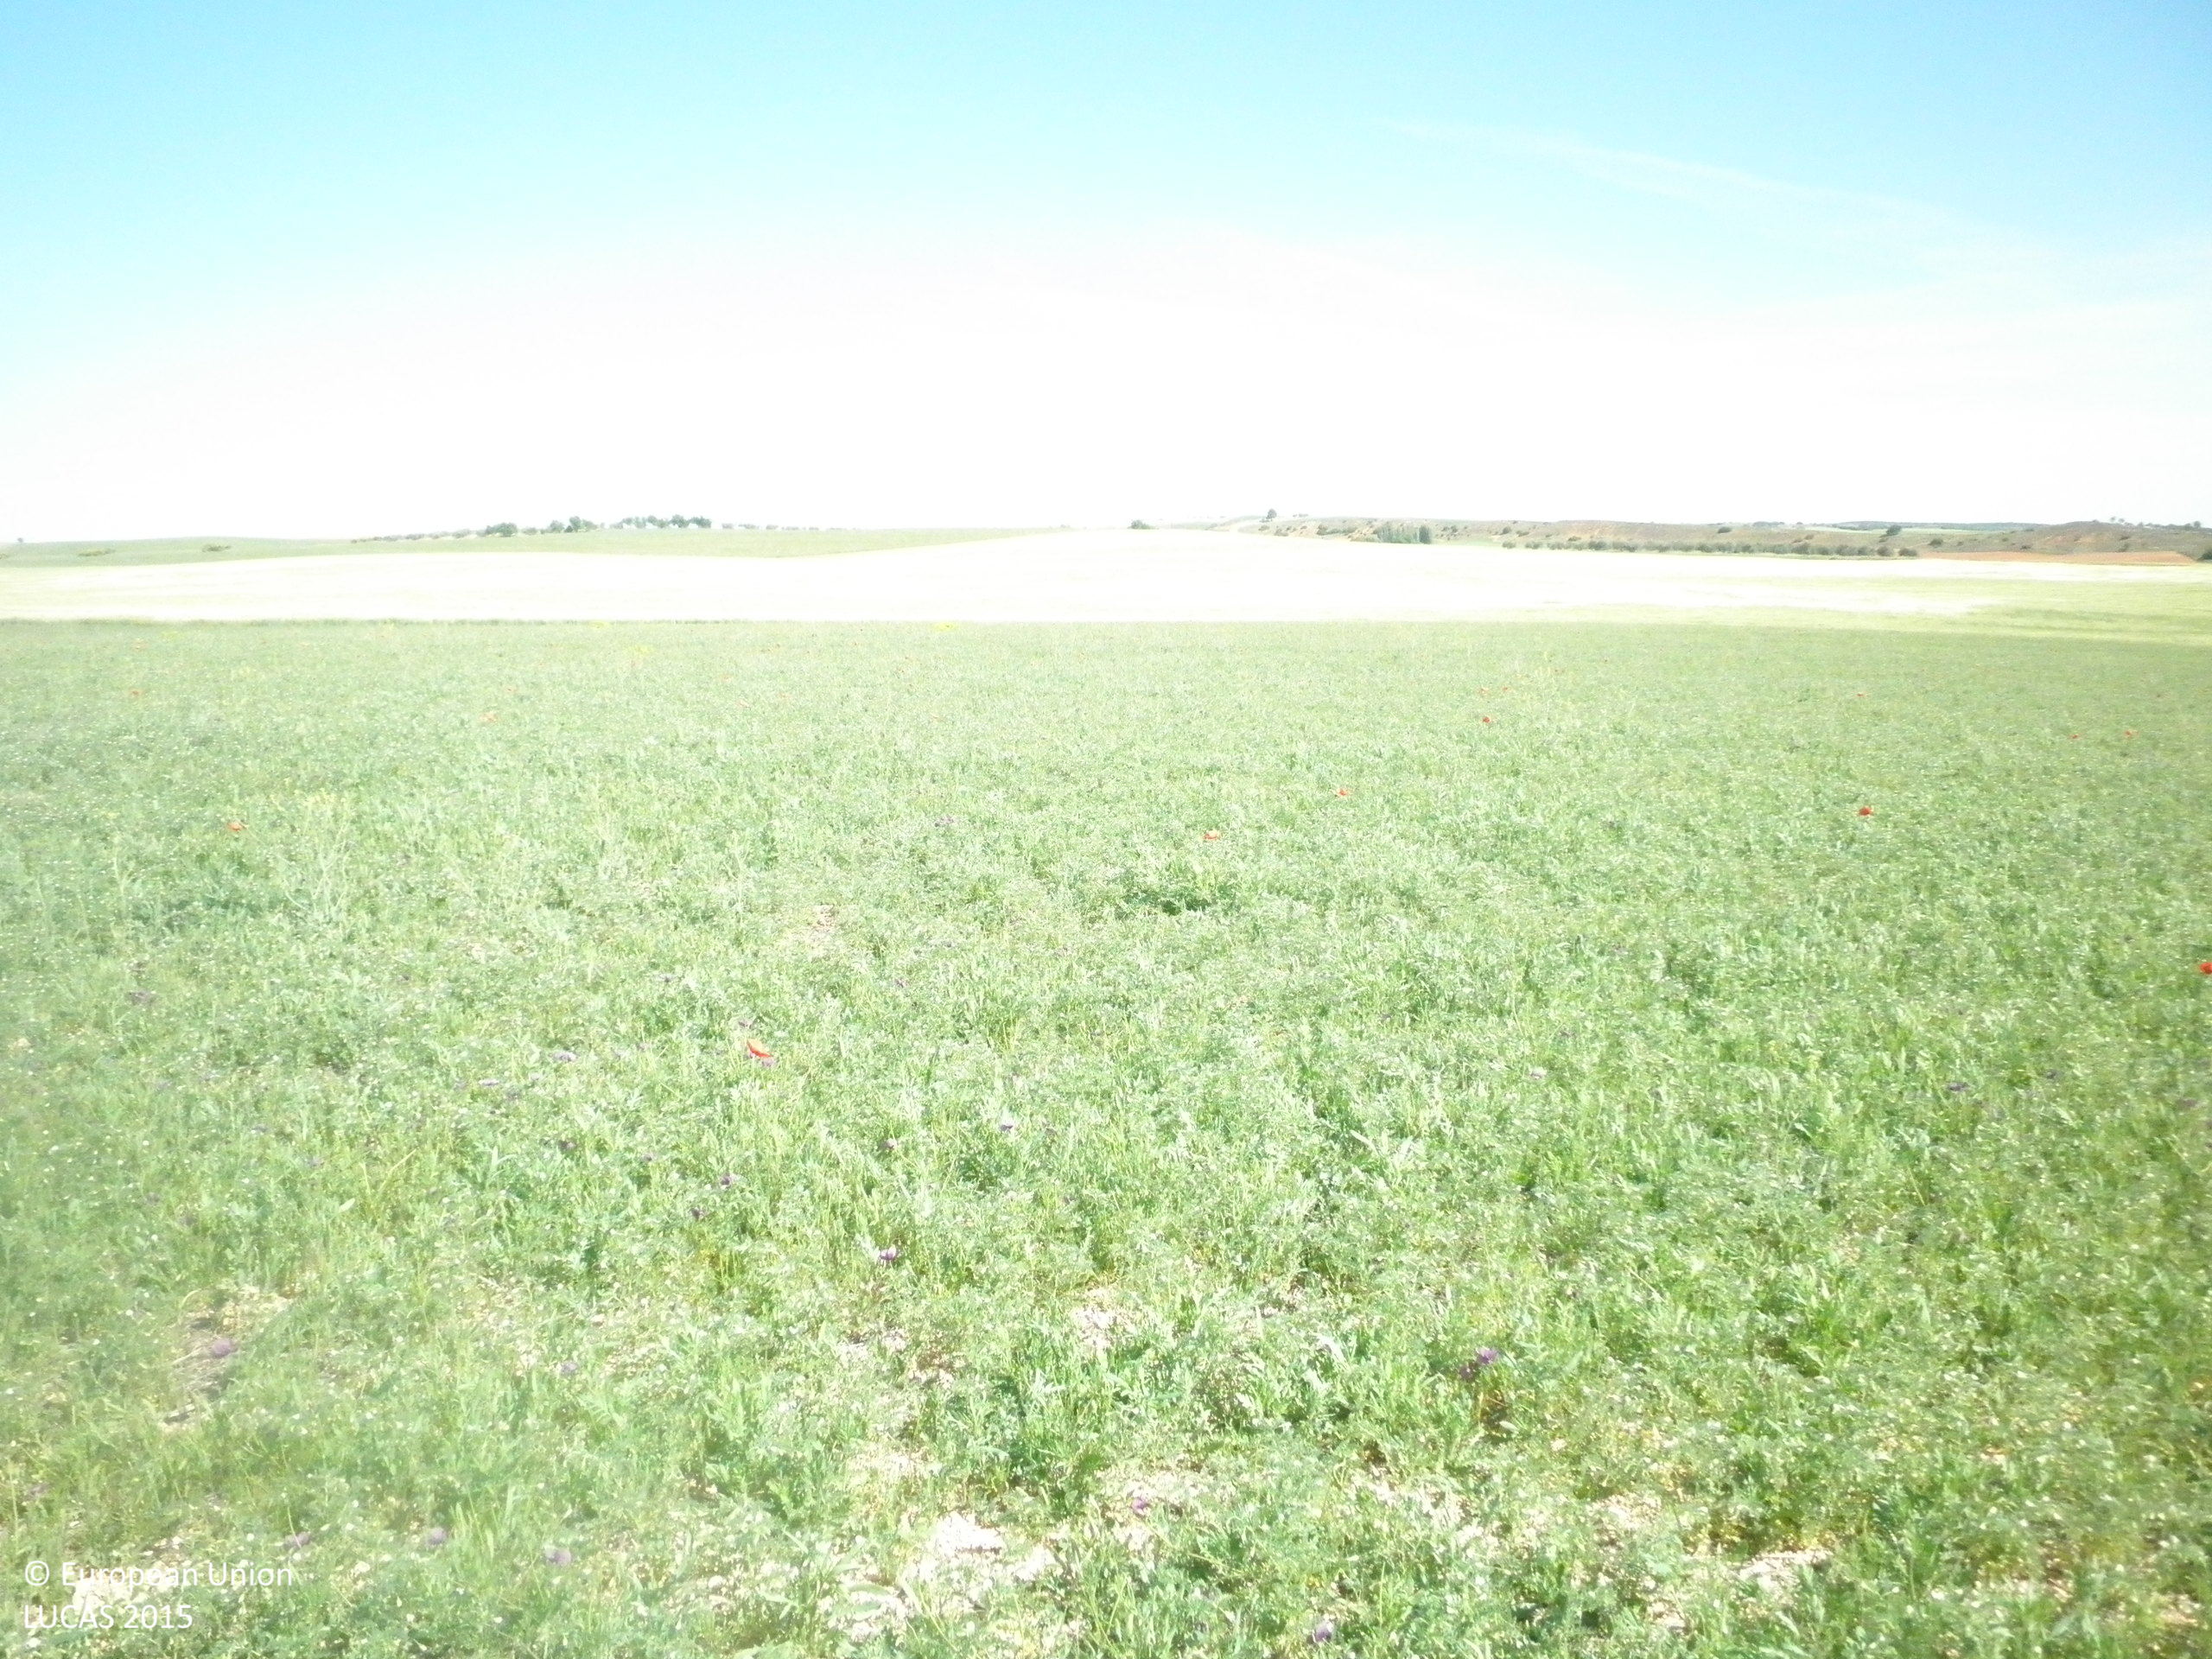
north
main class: Cropland
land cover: Dry pulses
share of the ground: > 75 %
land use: Agriculture (excluding fallow land and kitchen gardens)
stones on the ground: 10 - 25 %
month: May
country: ES
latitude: 39.7220
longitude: -2.7686
